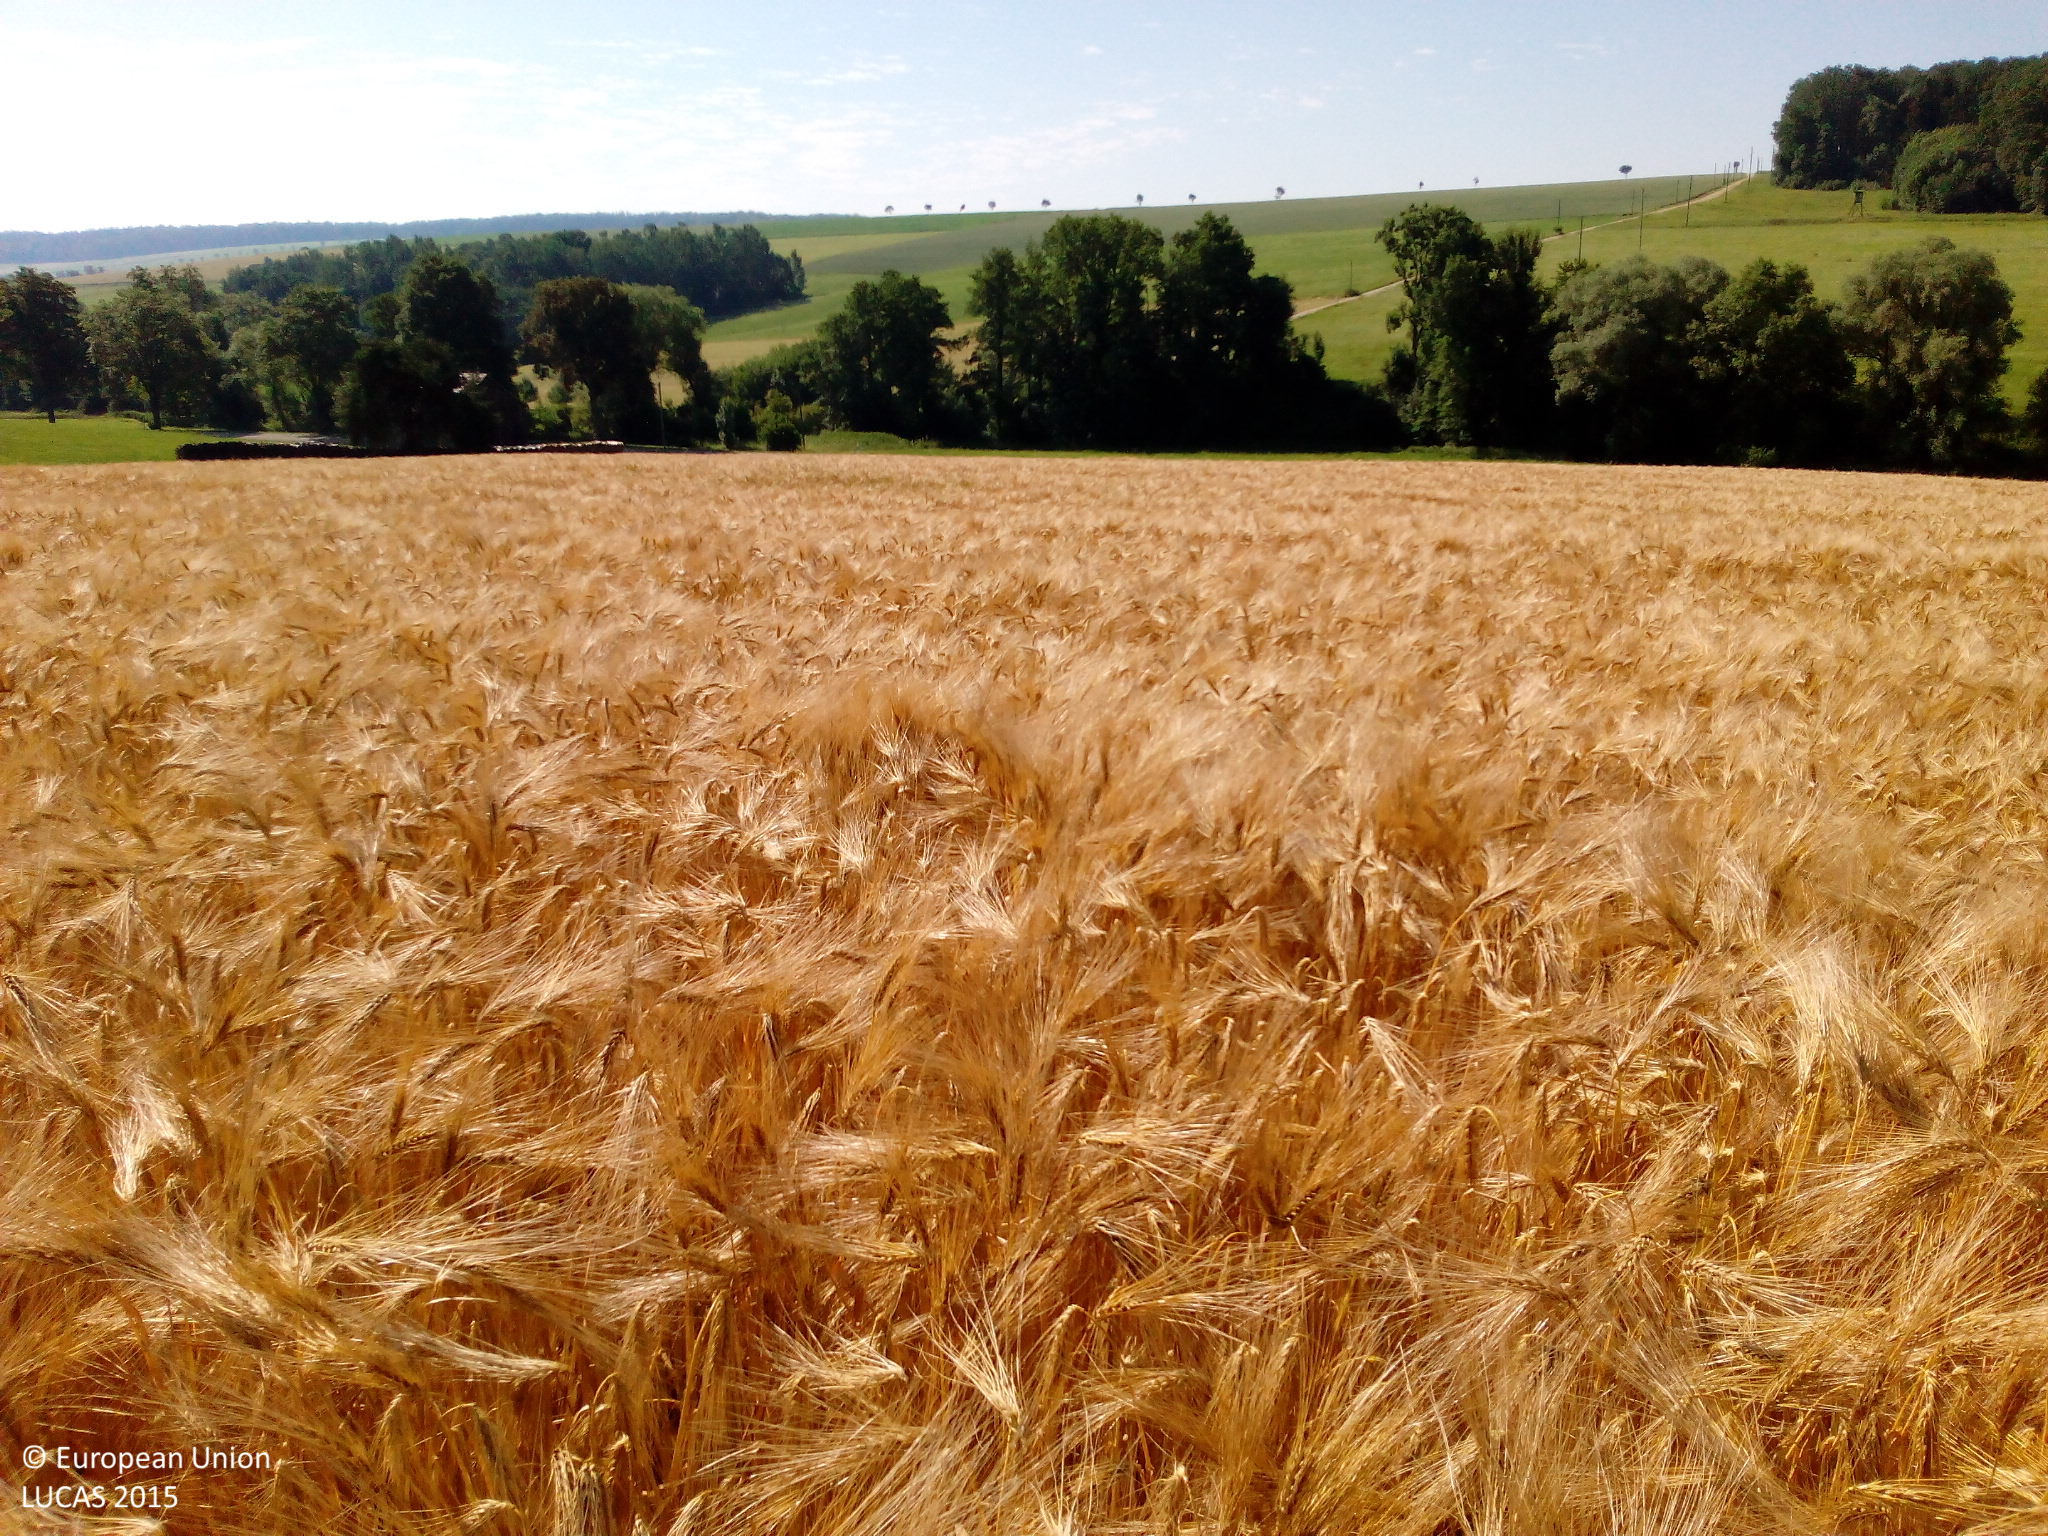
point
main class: Cropland
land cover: Barley
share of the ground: > 75 %
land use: Agriculture (excluding fallow land and kitchen gardens)
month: July
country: DE
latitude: 48.7958
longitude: 10.8844
